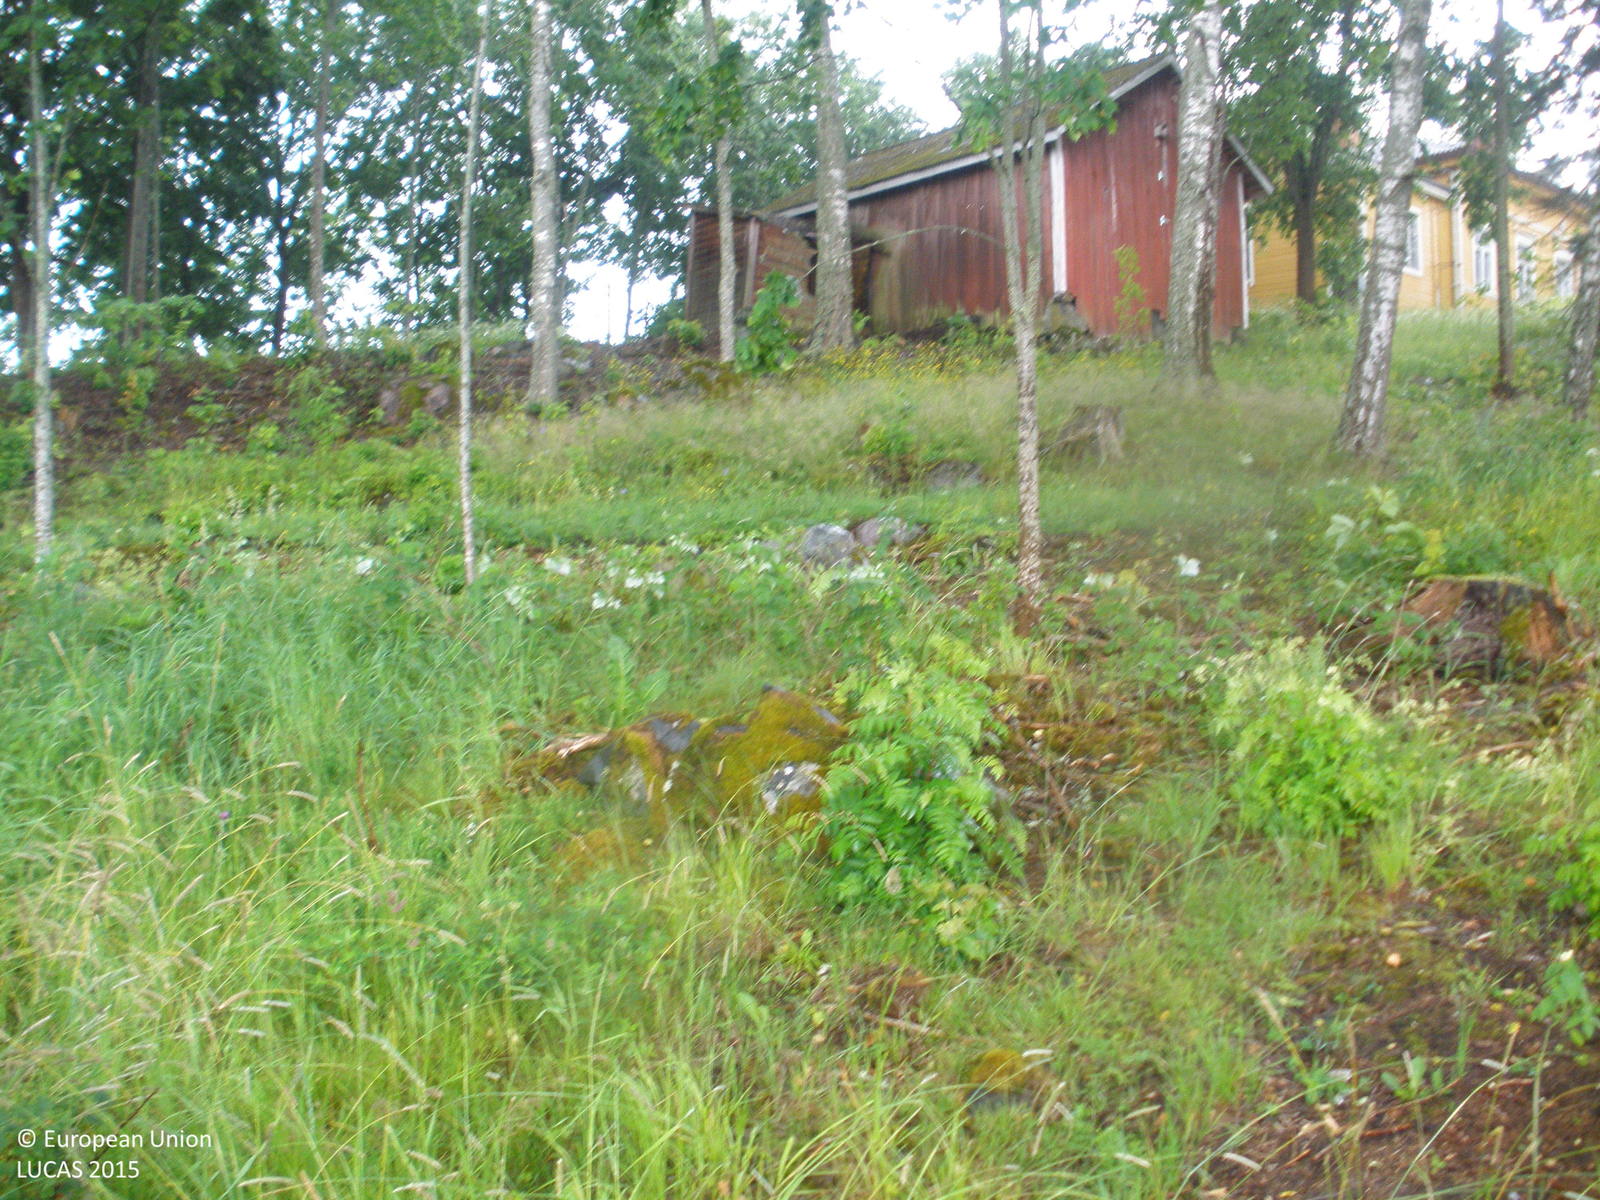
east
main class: Cropland
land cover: Oats
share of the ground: > 75 %
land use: Agriculture (excluding fallow land and kitchen gardens)
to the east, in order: Oats; Ditches and canals; Grassland with sparse tree/shrub cover; Broadleaved woodland; Electric lines; Broadleaved woodland; Inland marshes; Inland fresh water bodies
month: July
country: FI
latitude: 61.3182
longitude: 23.7386
